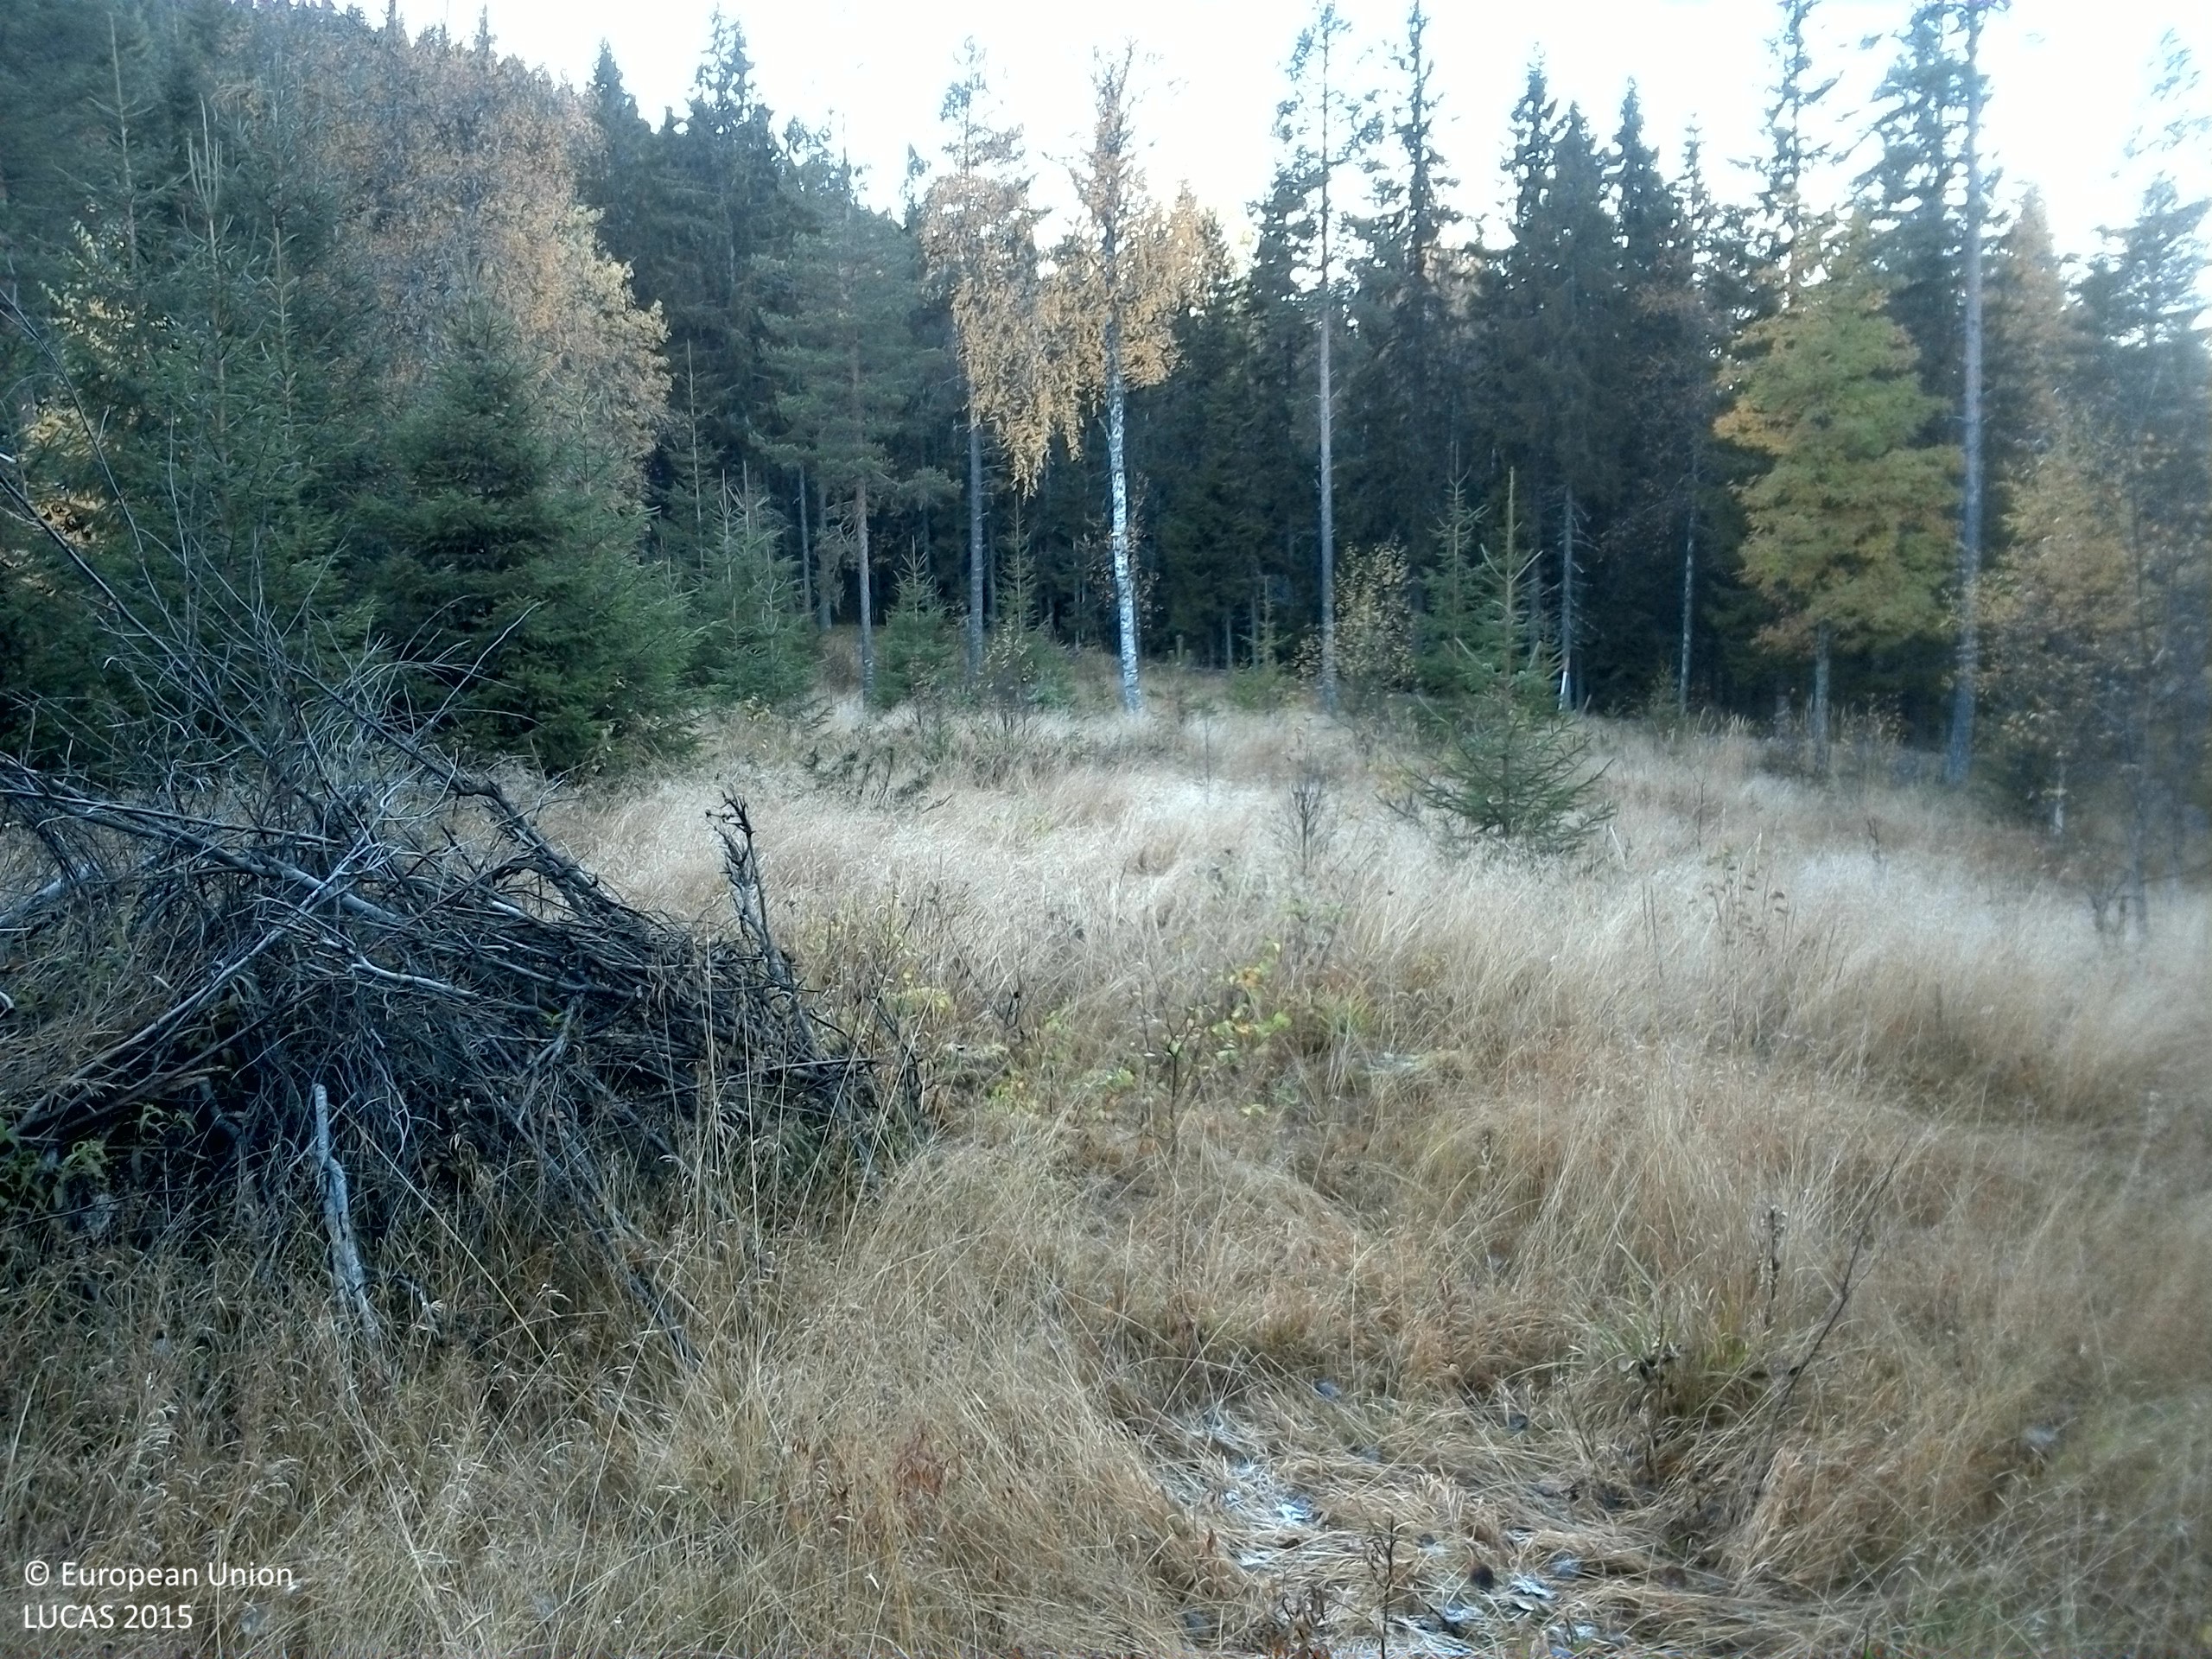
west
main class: Woodland
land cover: Pine dominated mixed woodland
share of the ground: 50 - 75 %
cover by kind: coniferous forest trees 30 %, herbaceous plants 30 %, broadleaved forest trees 25 %, shrubs 15 %
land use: Forestry
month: October
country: SE
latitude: 61.1629
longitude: 14.2428
